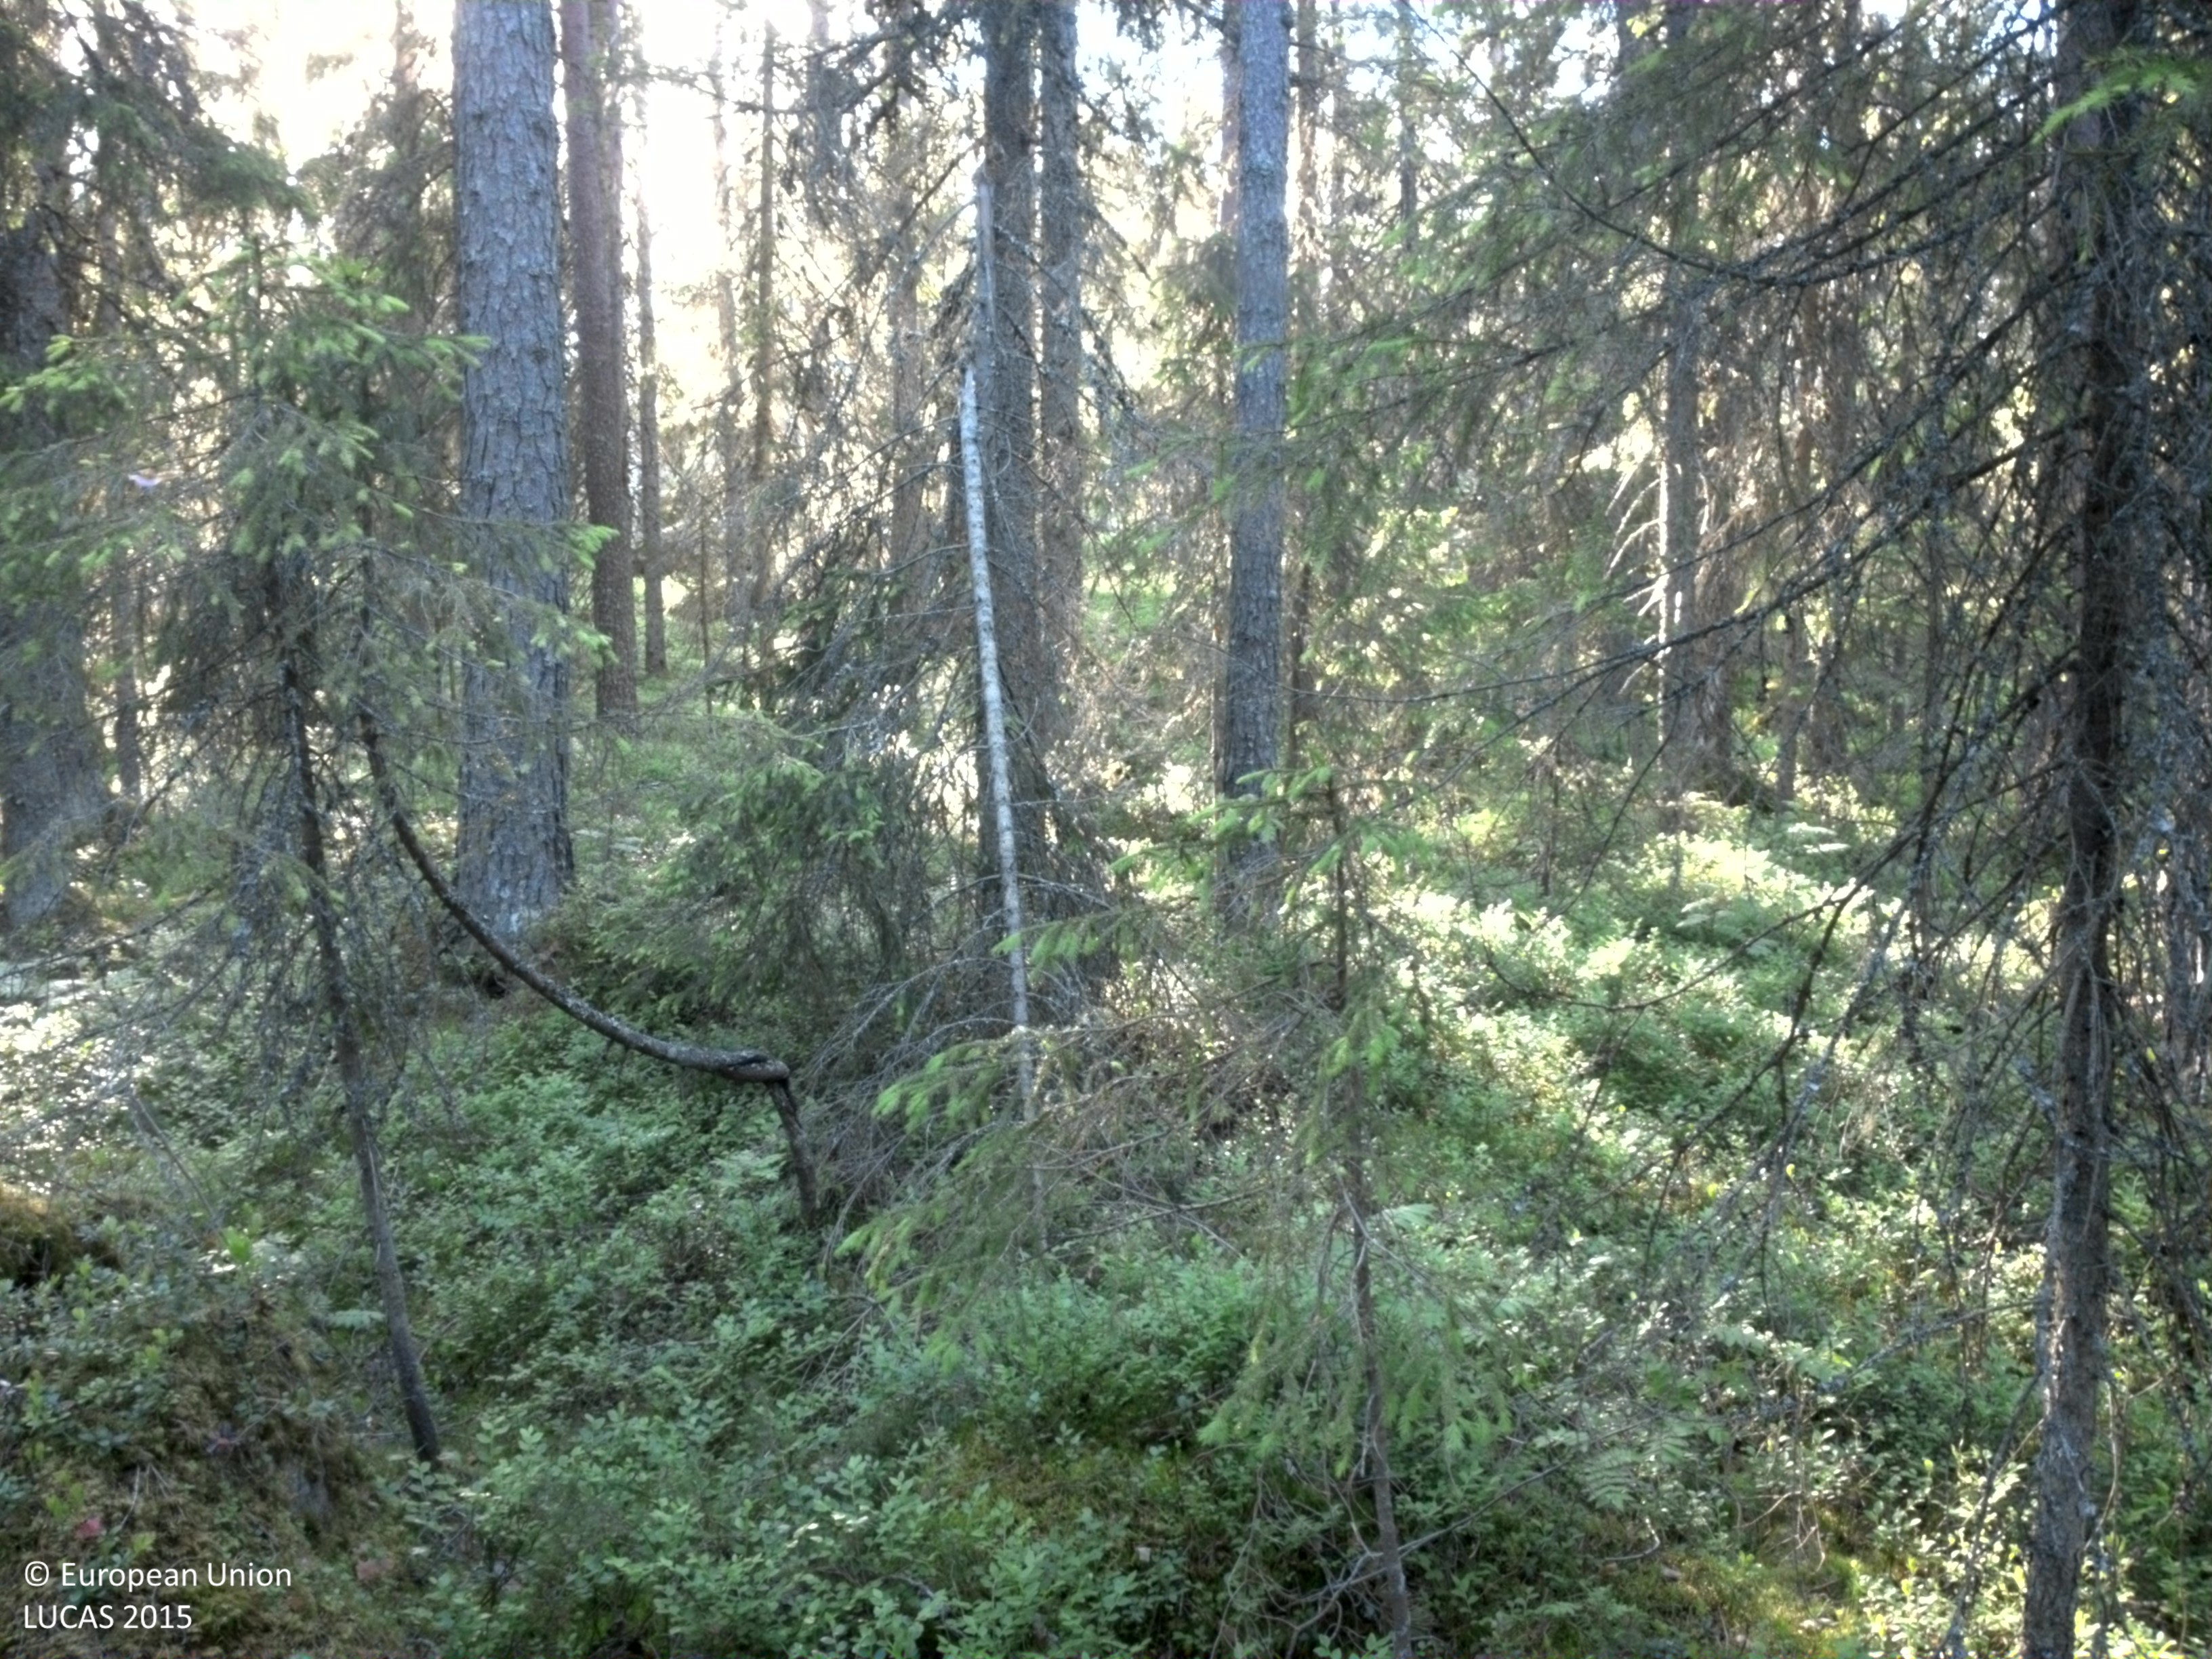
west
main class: Woodland
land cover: Spruce dominated coniferous woodland
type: boreal forest
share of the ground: 50 - 75 %
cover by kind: coniferous forest trees 75 %, shrubs 20 %, lichens and mosses 5 %
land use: Forestry
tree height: > 5 m
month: June
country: SE
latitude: 64.2404
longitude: 20.6428
